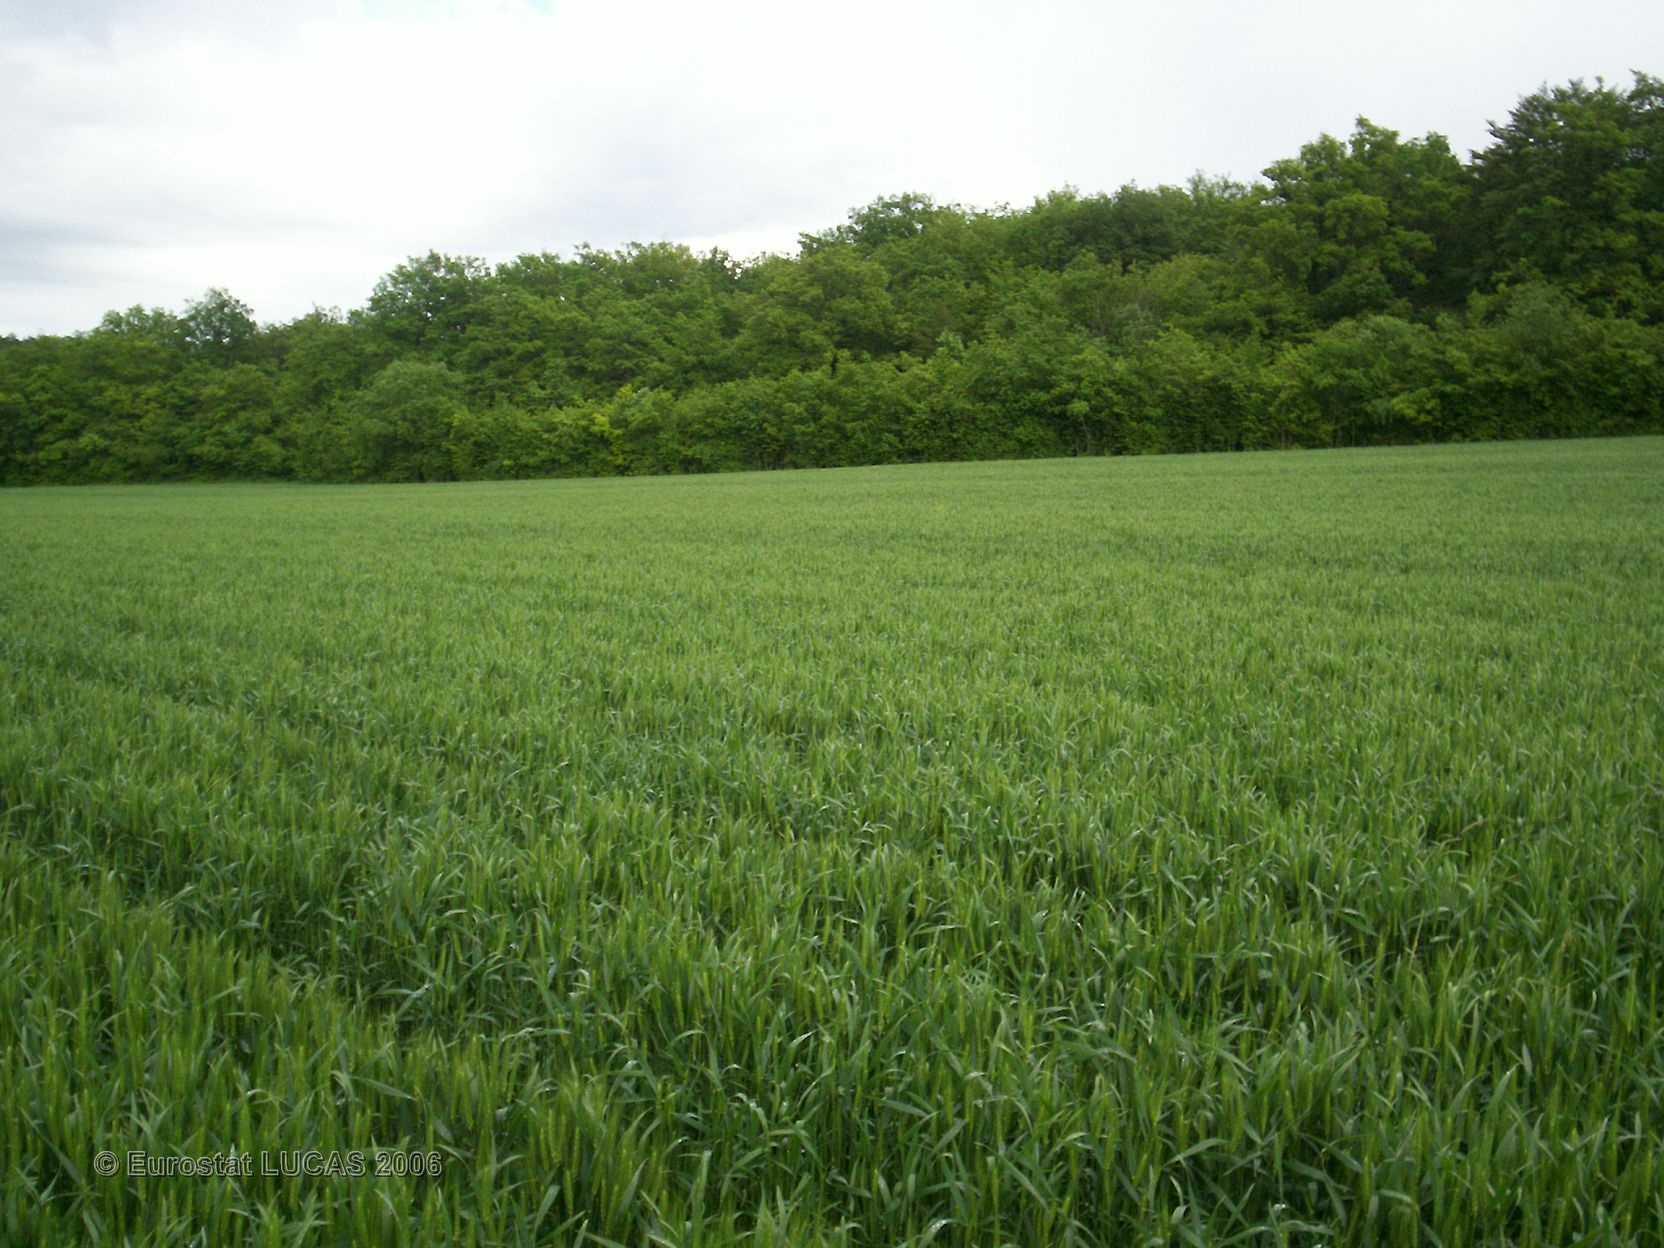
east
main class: Cropland
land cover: Barley
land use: Agriculture (excluding fallow land and kitchen gardens)
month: May
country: FR
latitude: 47.4981
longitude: 5.0221
